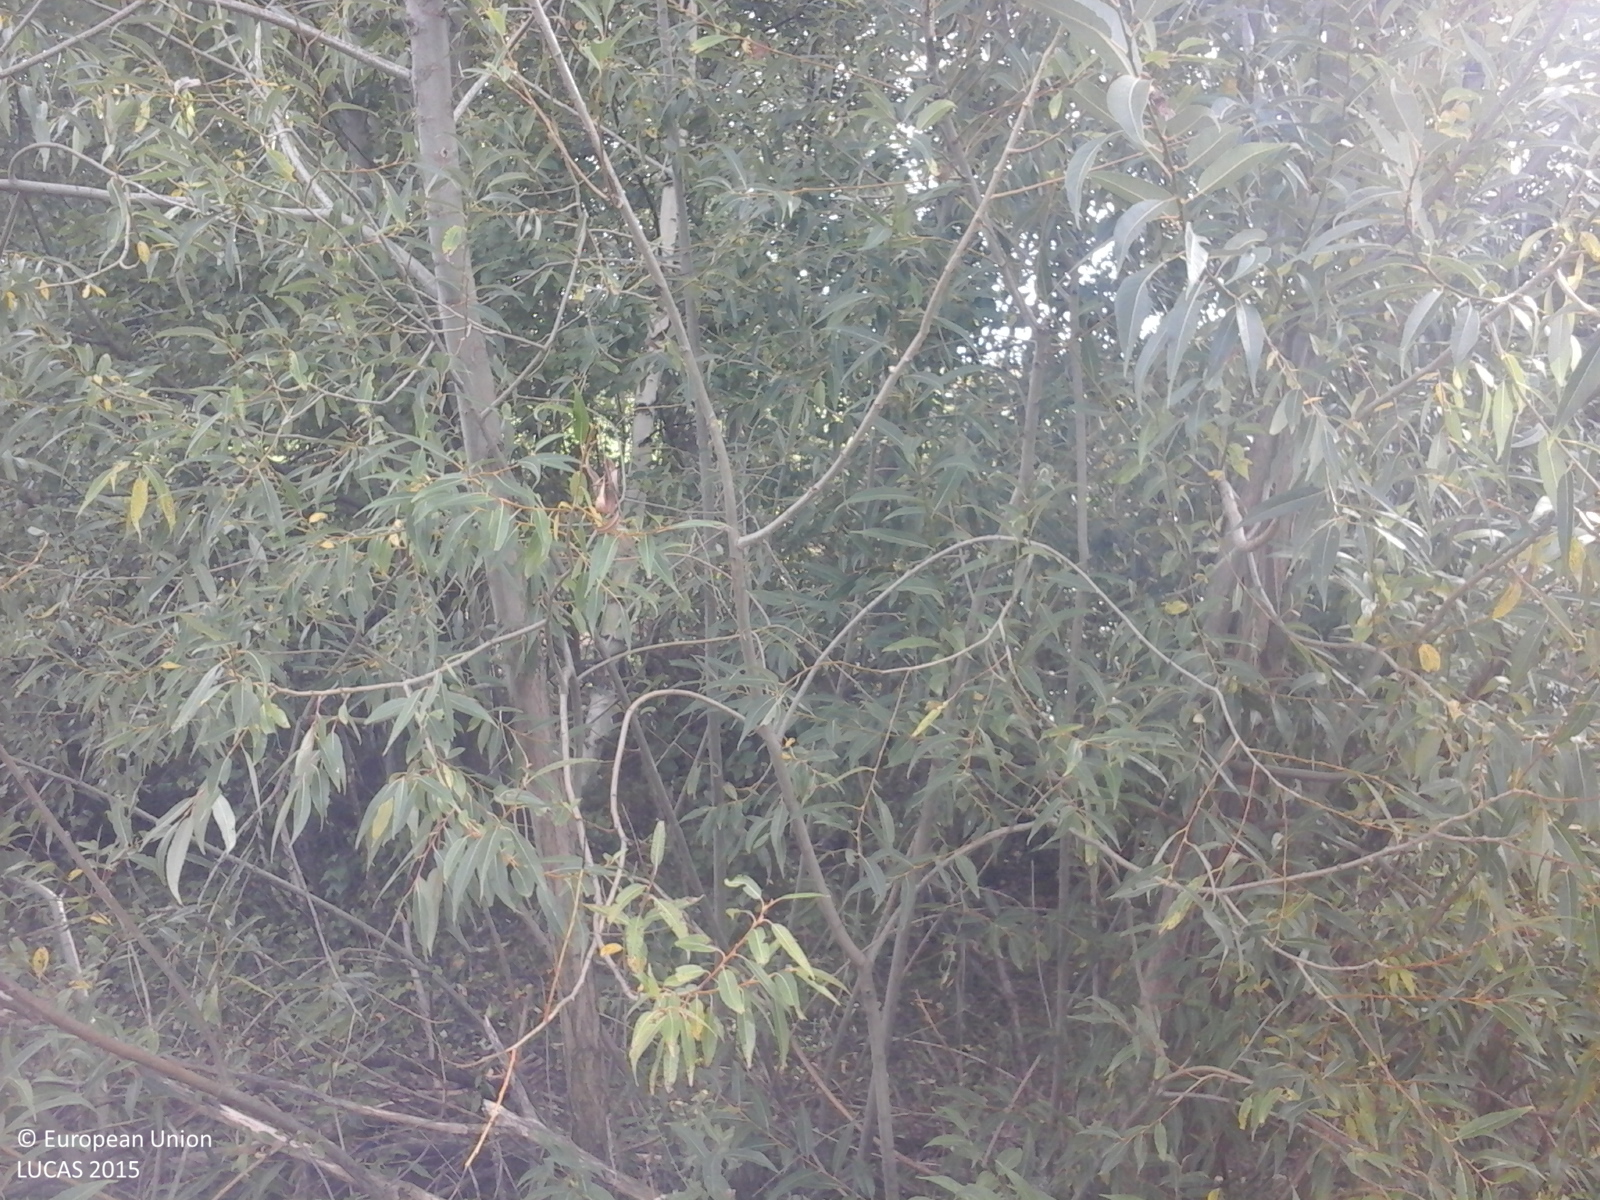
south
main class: Grassland
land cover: Grassland without tree/shrub cover
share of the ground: > 75 %
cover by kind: herbaceous plants 100 %
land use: Agriculture (excluding fallow land and kitchen gardens)
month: September
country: RO
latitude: 46.6649
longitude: 23.3050
